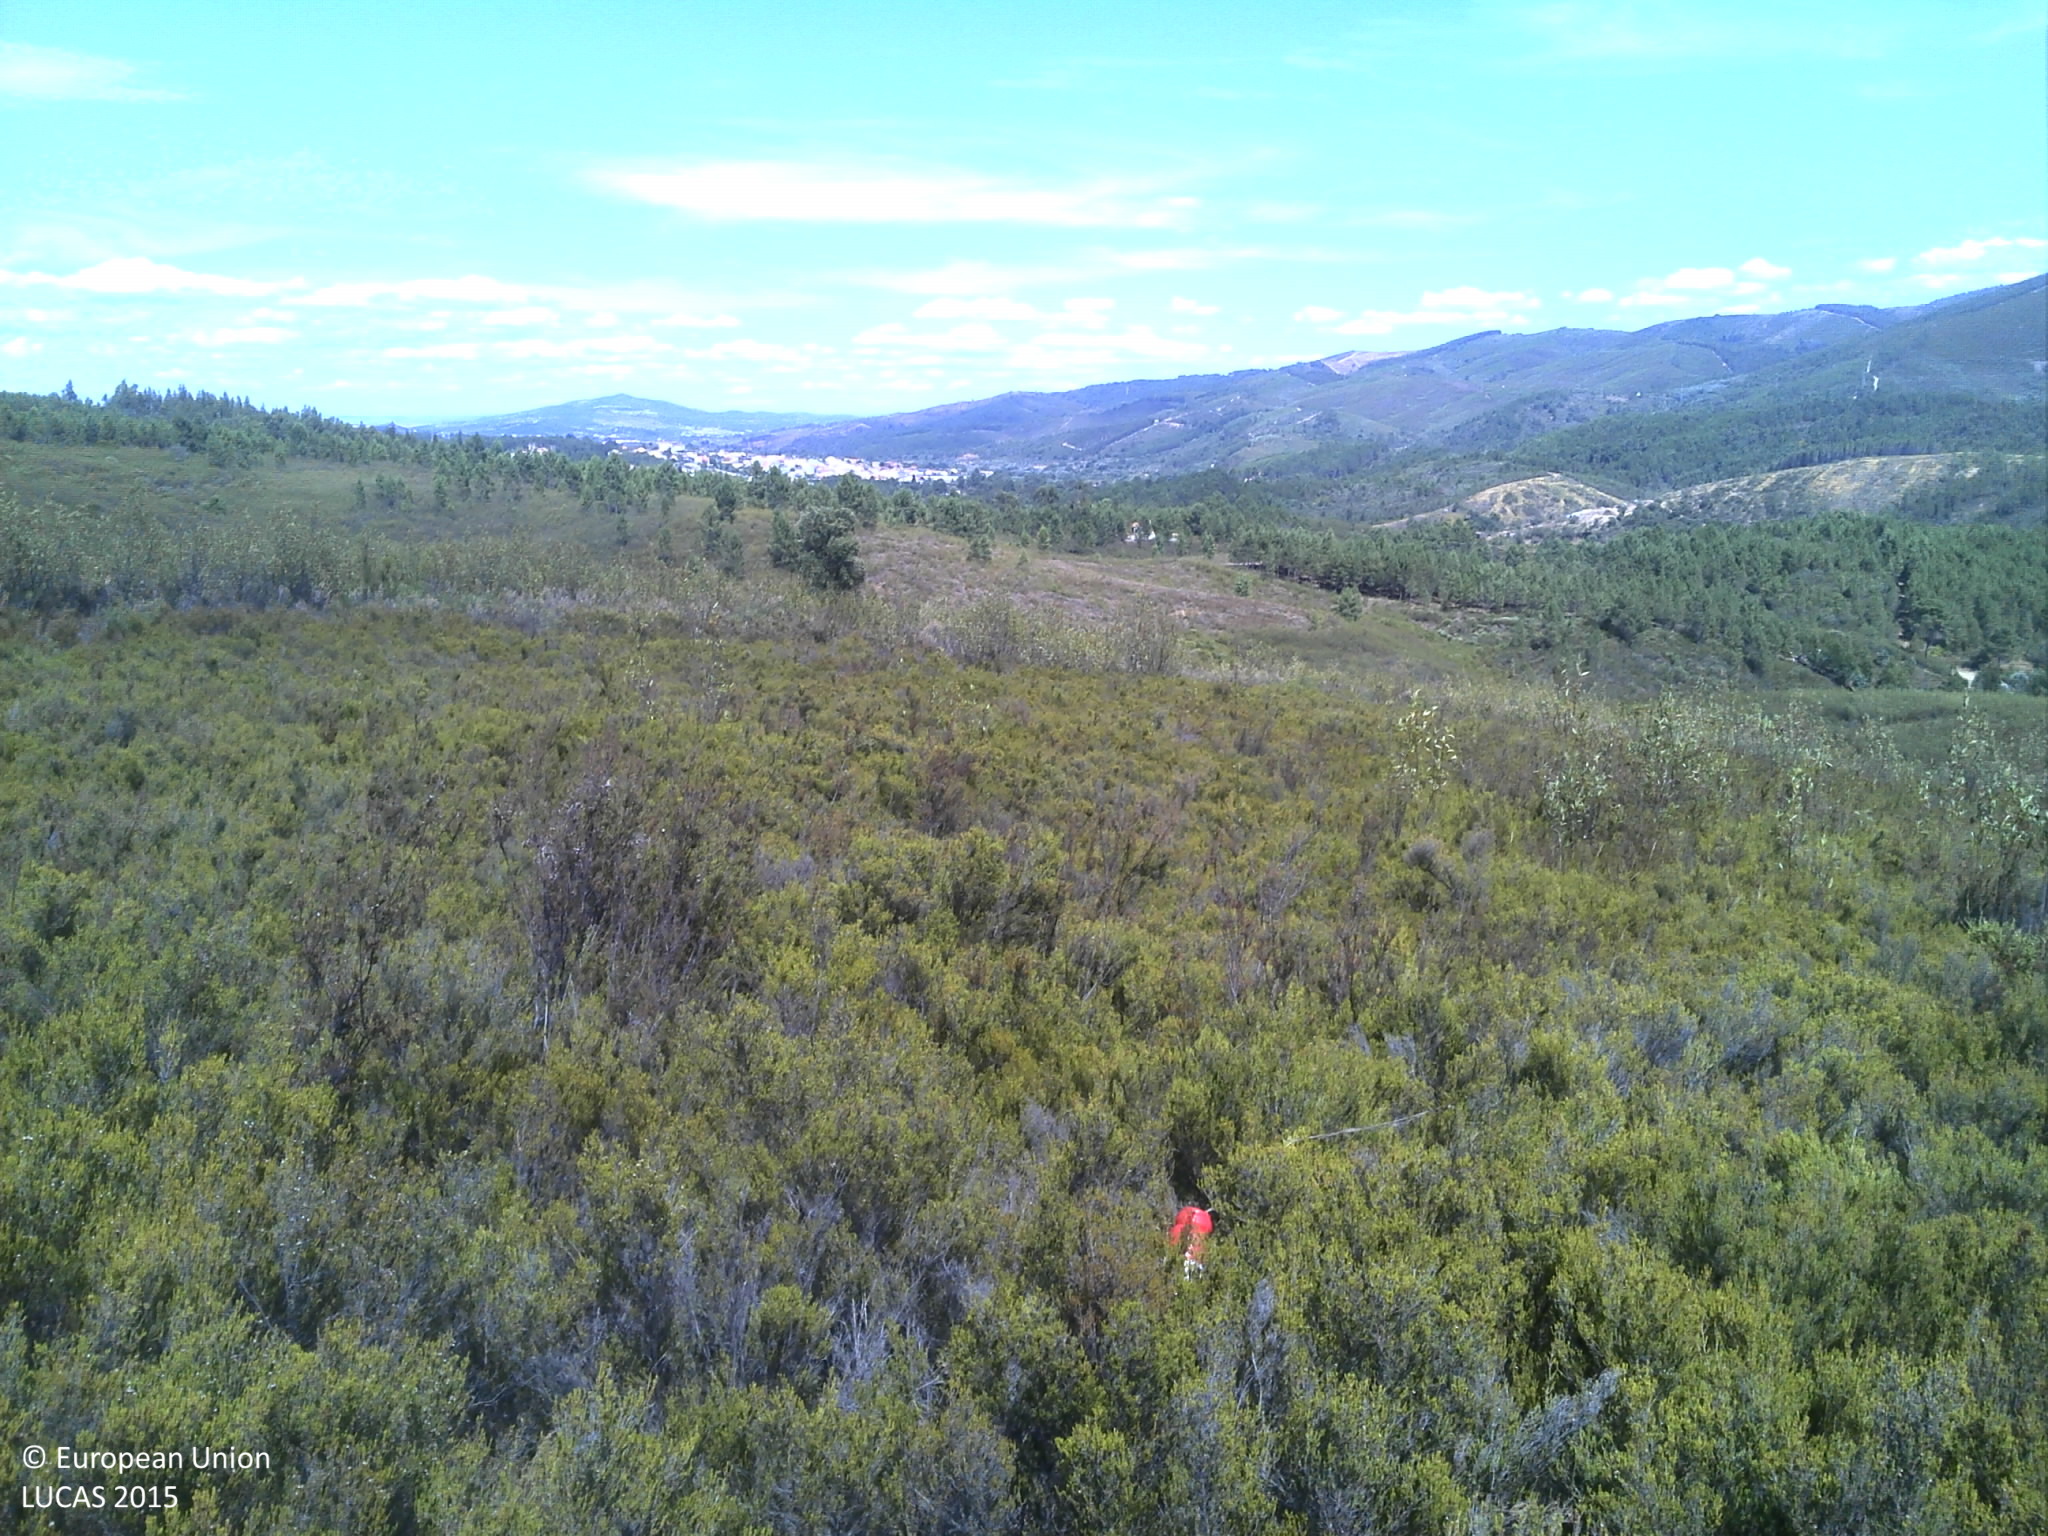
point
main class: Shrubland
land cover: Shrubland without tree cover
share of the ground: > 75 %
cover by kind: shrubs 80 %, unconsolidated bare surface 20 %
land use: Abandoned areas
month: July
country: PT
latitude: 40.1687
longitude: -7.6399
